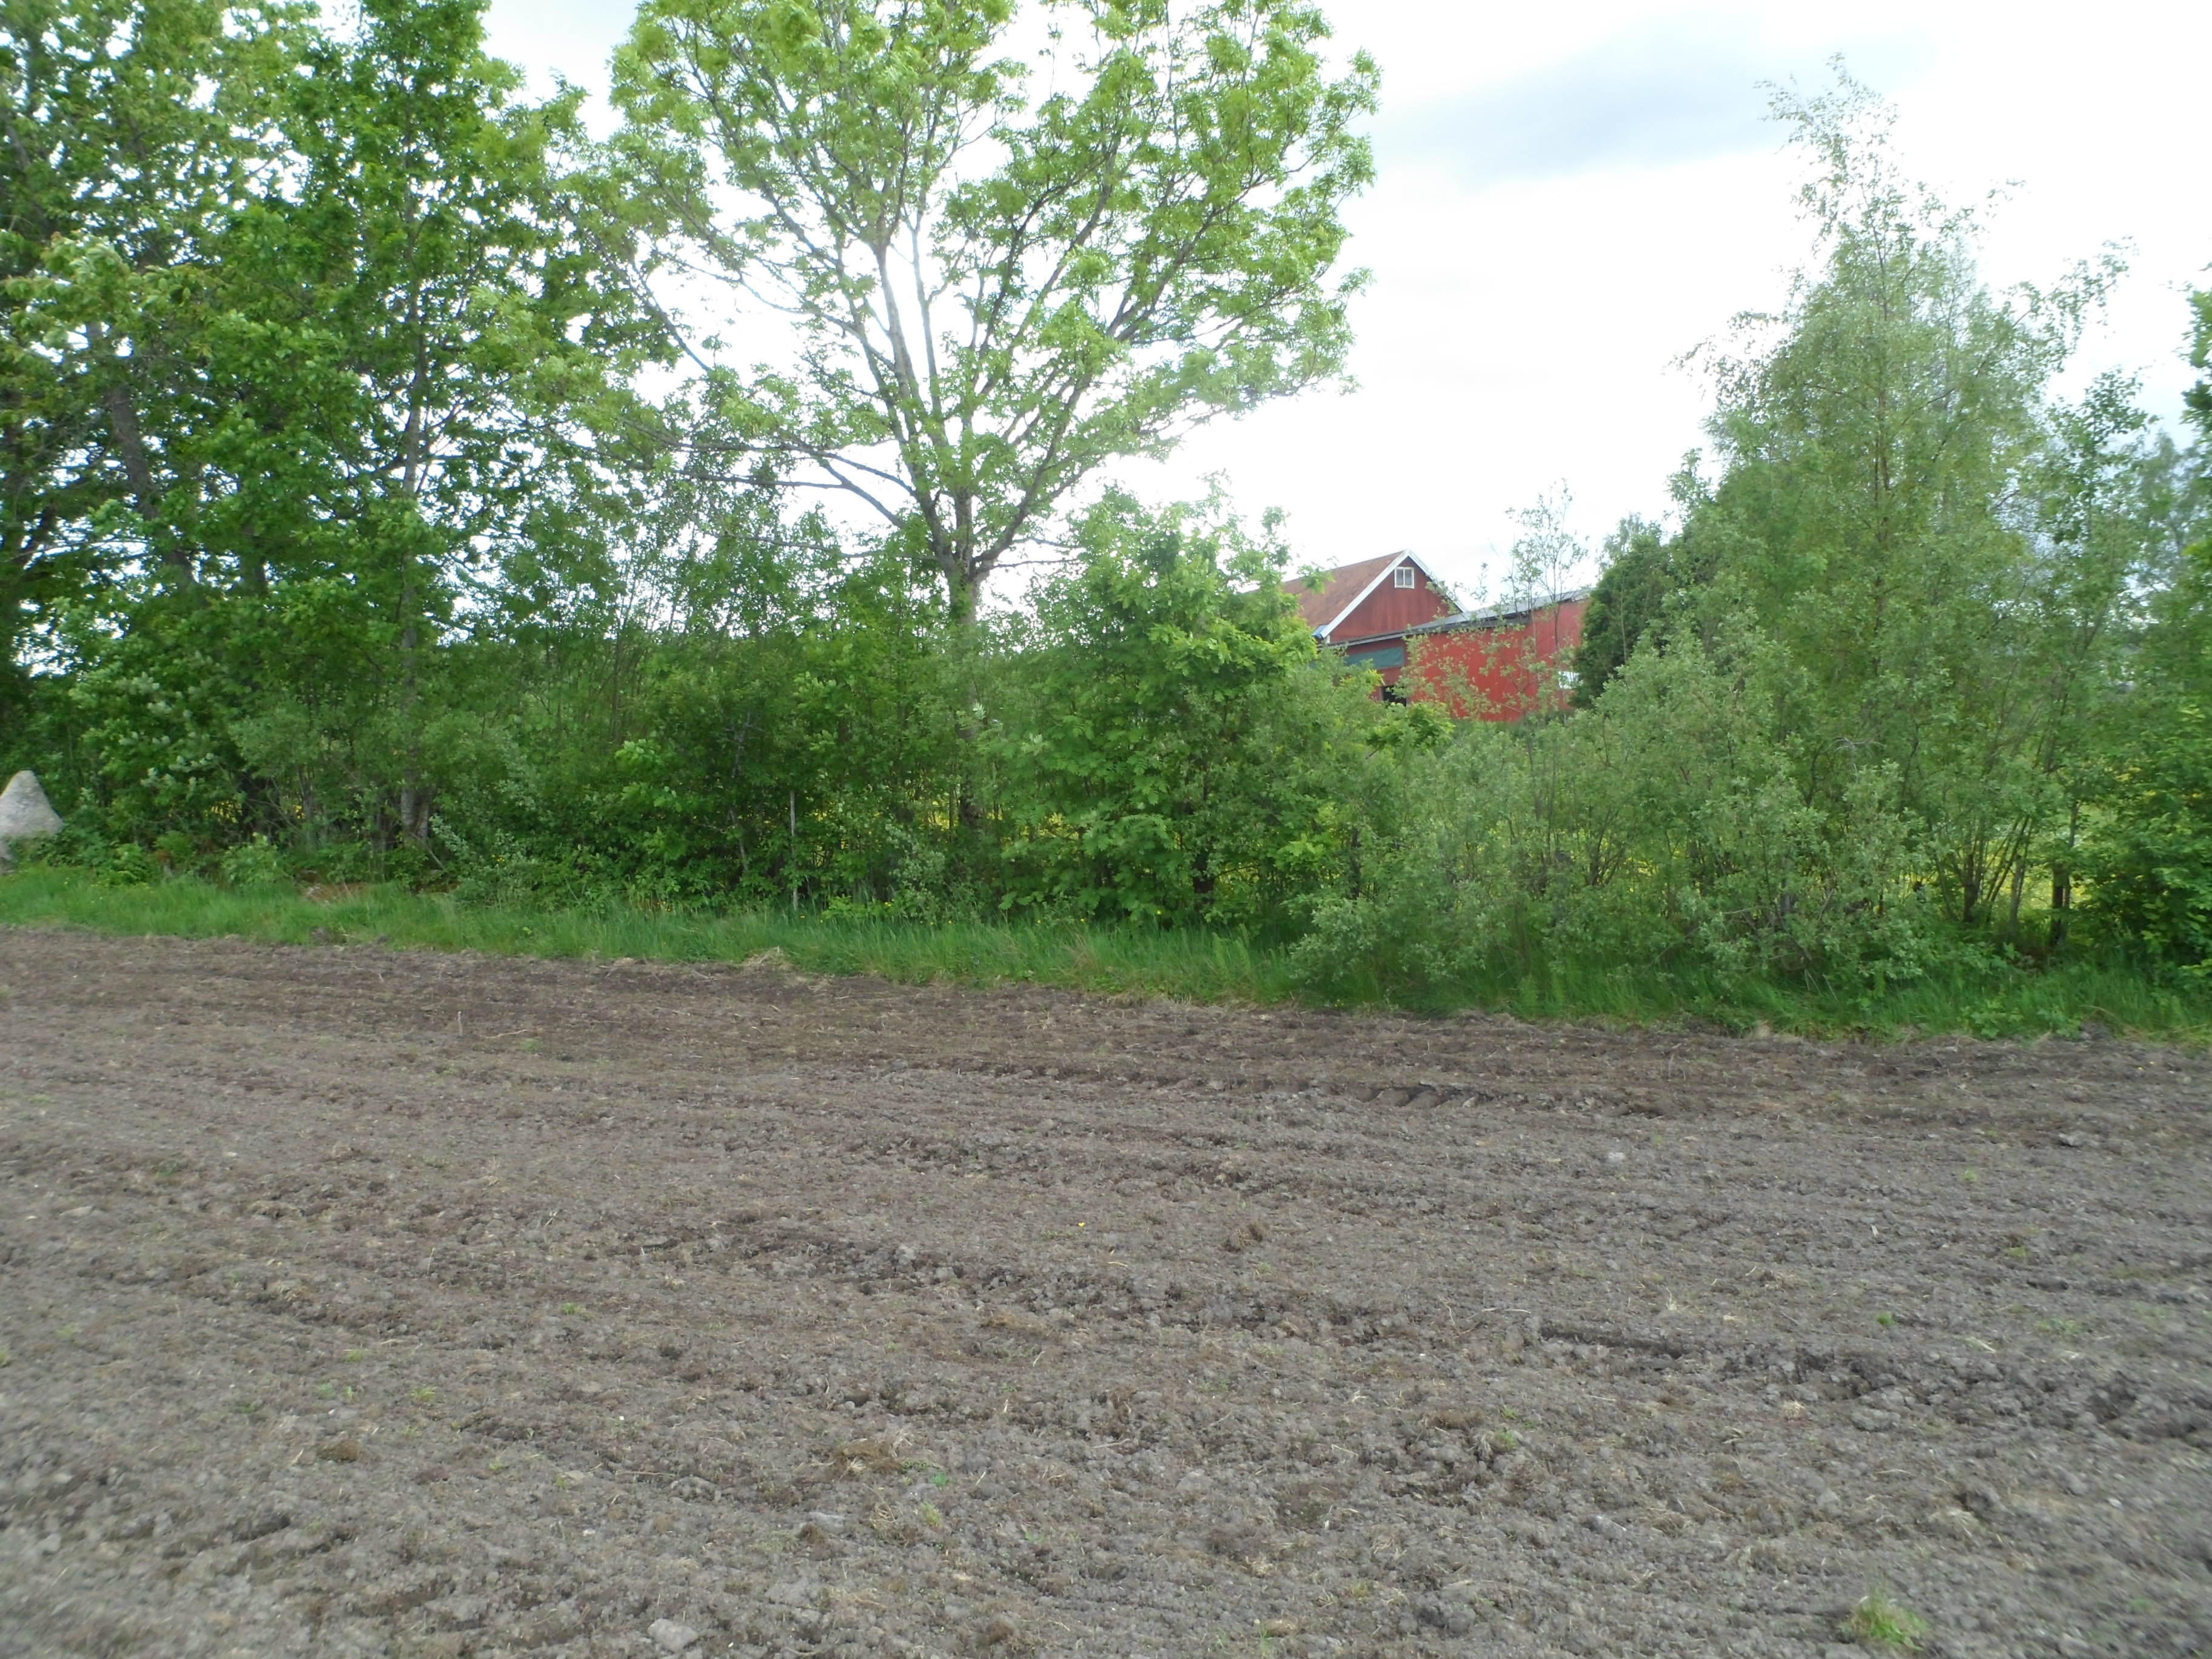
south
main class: Cropland
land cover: Other leguminous and mixtures for fodder
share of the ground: < 10 %
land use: Agriculture (excluding fallow land and kitchen gardens)
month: June
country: SE
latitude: 57.2548
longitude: 14.1566
